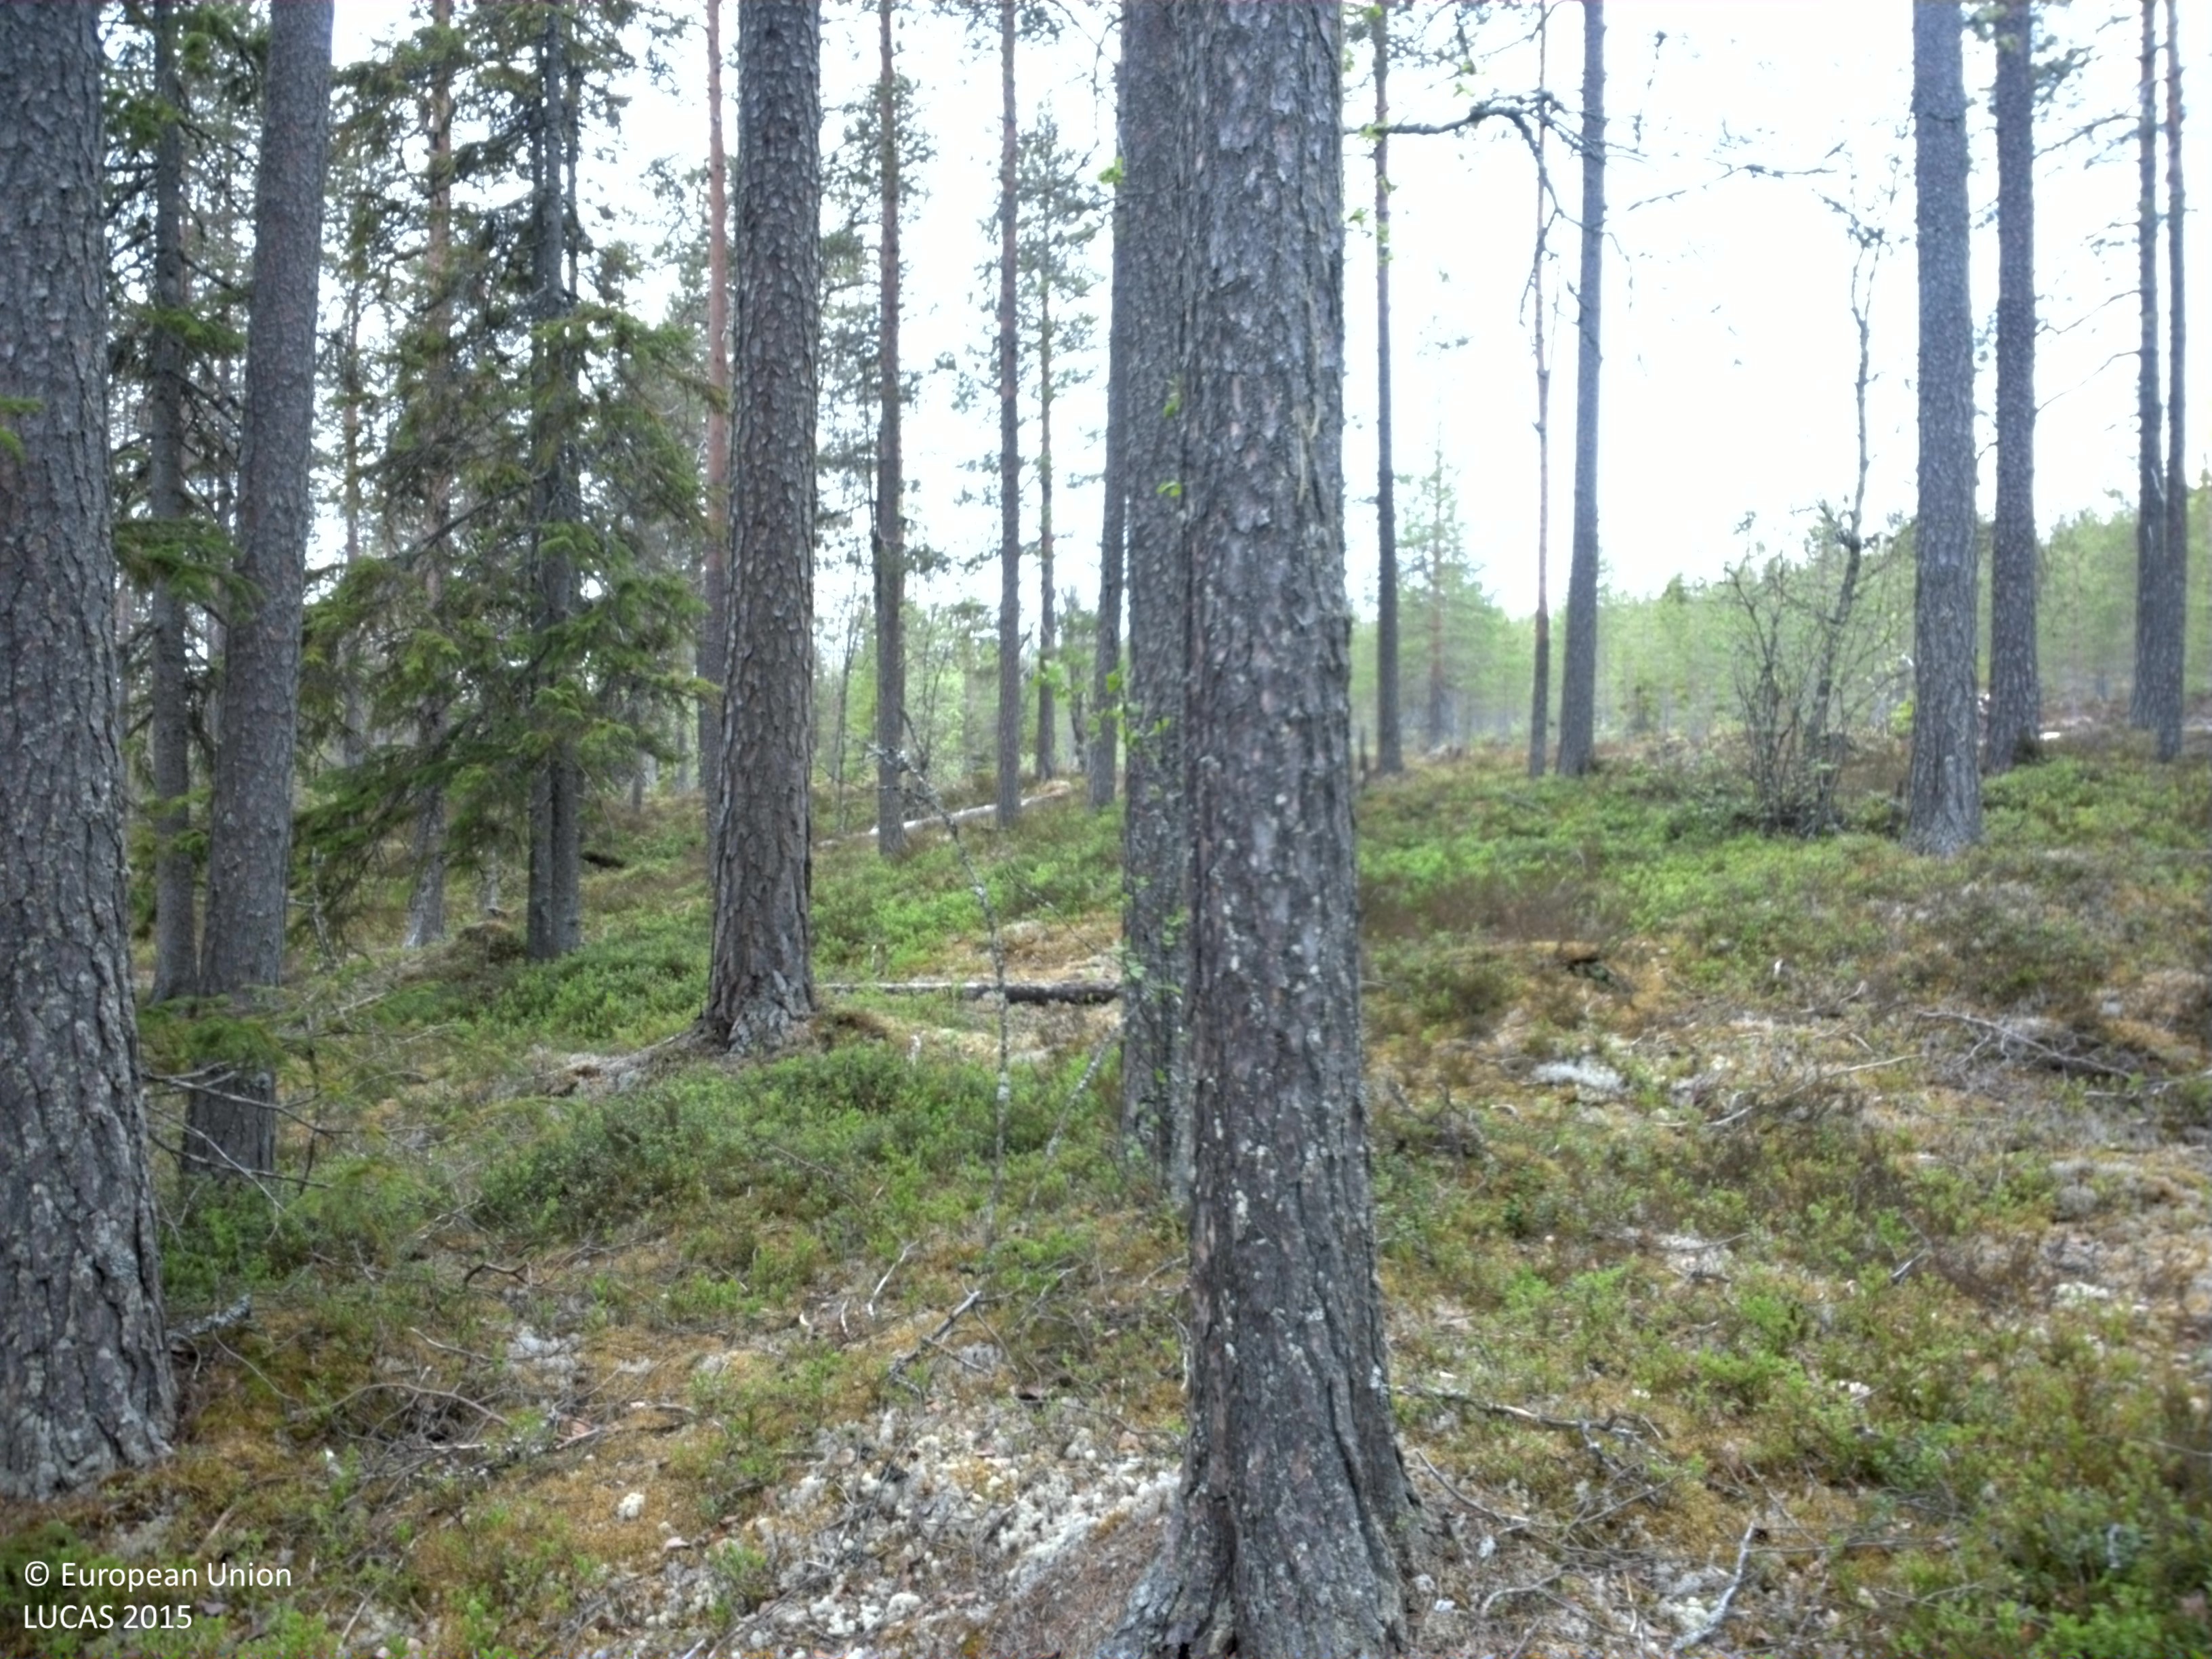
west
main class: Woodland
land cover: Pine dominated mixed woodland
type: boreal forest
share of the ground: 50 - 75 %
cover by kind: coniferous forest trees 45 %, broadleaved forest trees 25 %, shrubs 20 %, lichens and mosses 10 %
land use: Forestry
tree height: > 5 m
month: June
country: SE
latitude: 61.7734
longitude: 13.6819
